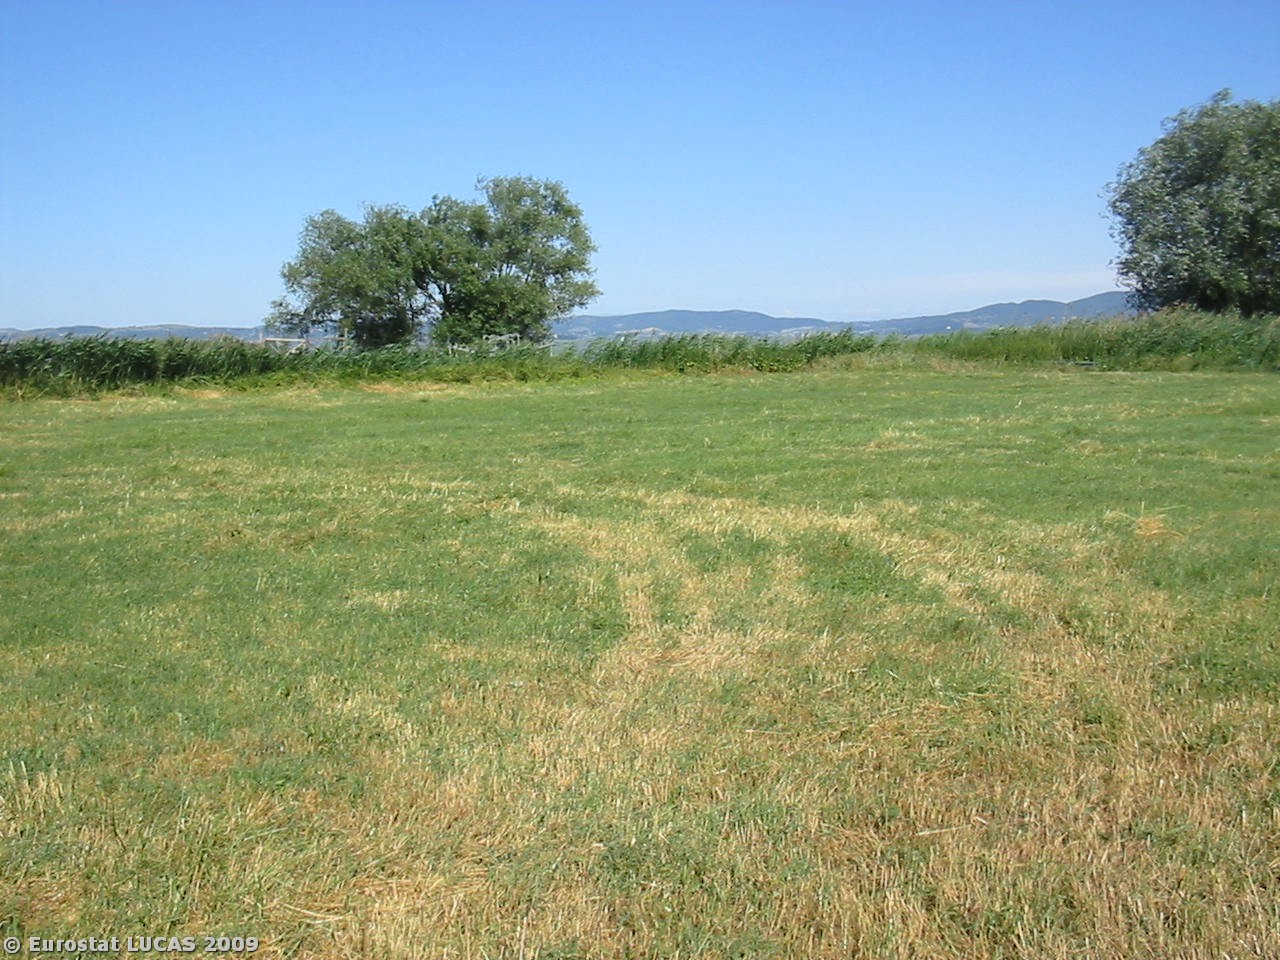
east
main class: Grassland
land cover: Grassland without tree/shrub cover
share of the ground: > 75 %
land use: Agriculture (excluding fallow land and kitchen gardens)
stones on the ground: < 10 %
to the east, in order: Grassland without tree/shrub cover; Shruby margins; Ditches and canals; Shruby margins; Grassland without tree/shrub cover; Paved roads, cycling and walking lanes; Fences; Shrubland with sparse tree cover; Inland water bodies
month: May
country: IT
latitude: 43.1210
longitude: 12.0466
